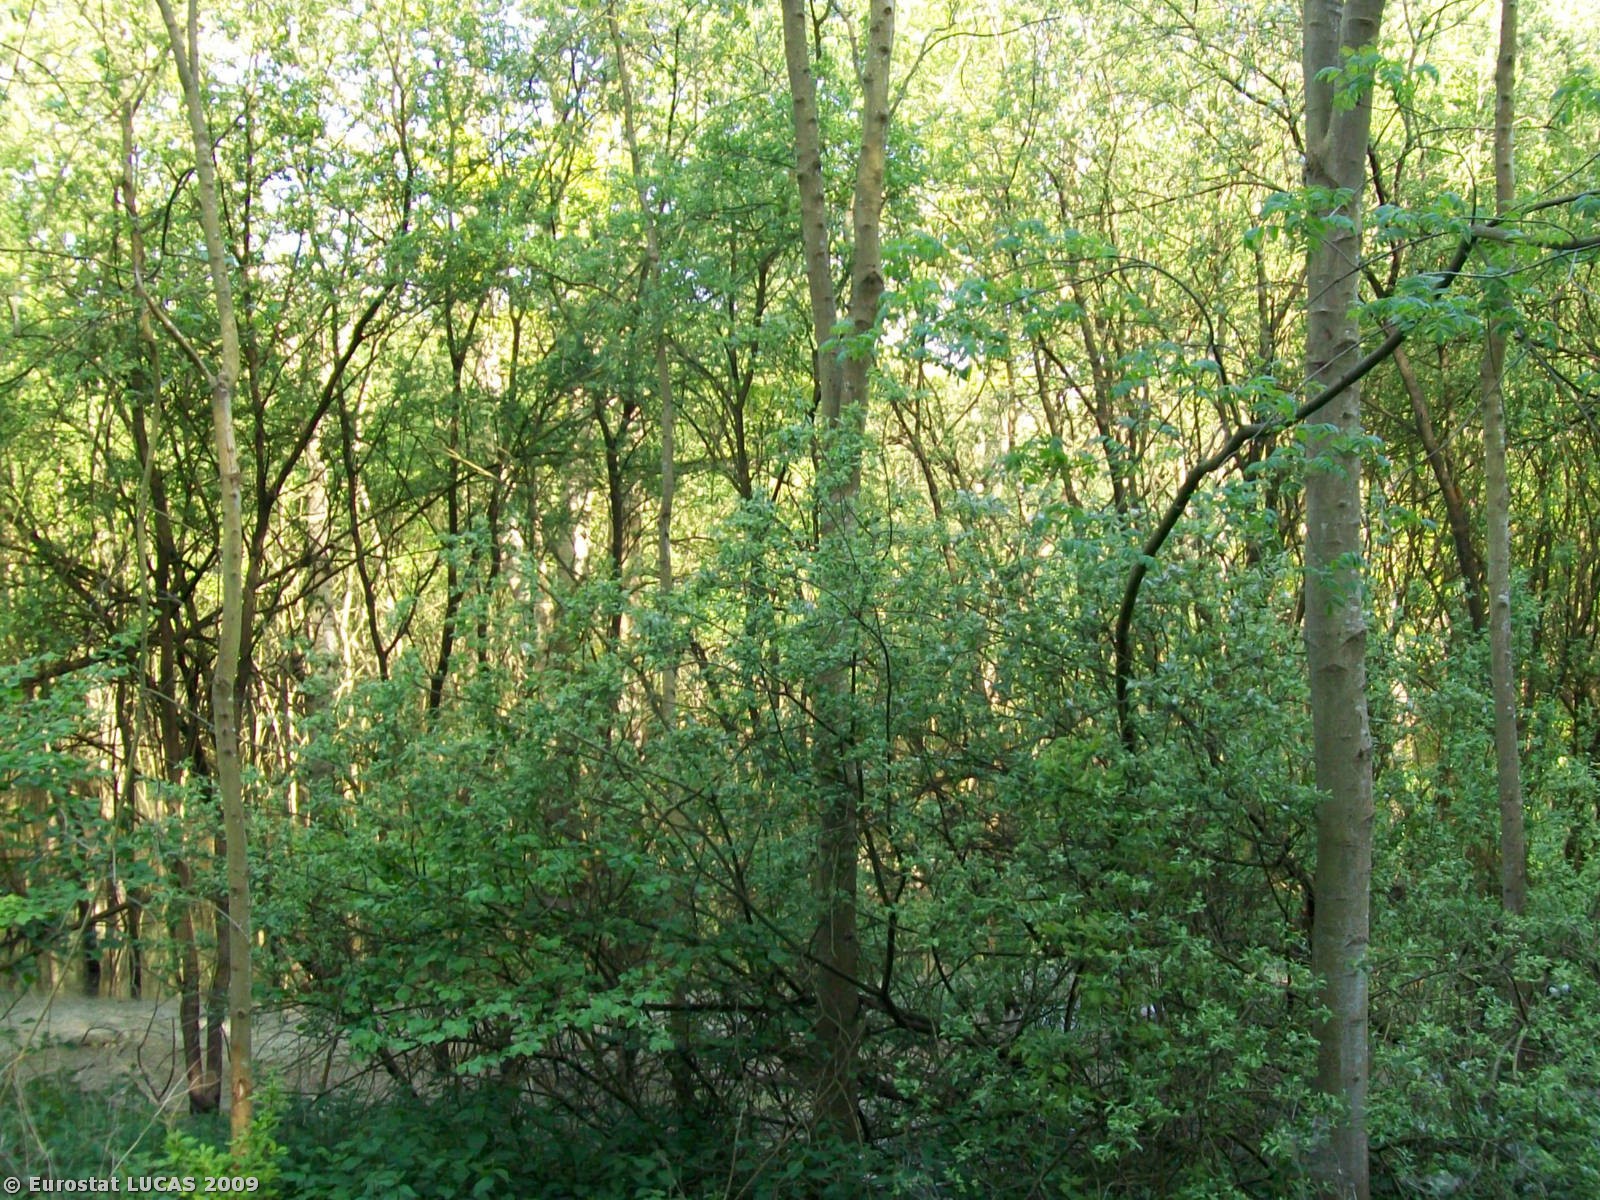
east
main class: Cropland
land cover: Maize
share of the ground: < 10 %
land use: Agriculture (excluding fallow land and kitchen gardens)
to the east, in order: Maize; Managed hedges; Electric lines; Groves; Paved roads, cycling and walking lanes; Managed hedges; Fences; Grassland without tree/shrub cover
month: May
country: GB
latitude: 52.3505
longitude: -2.5011
